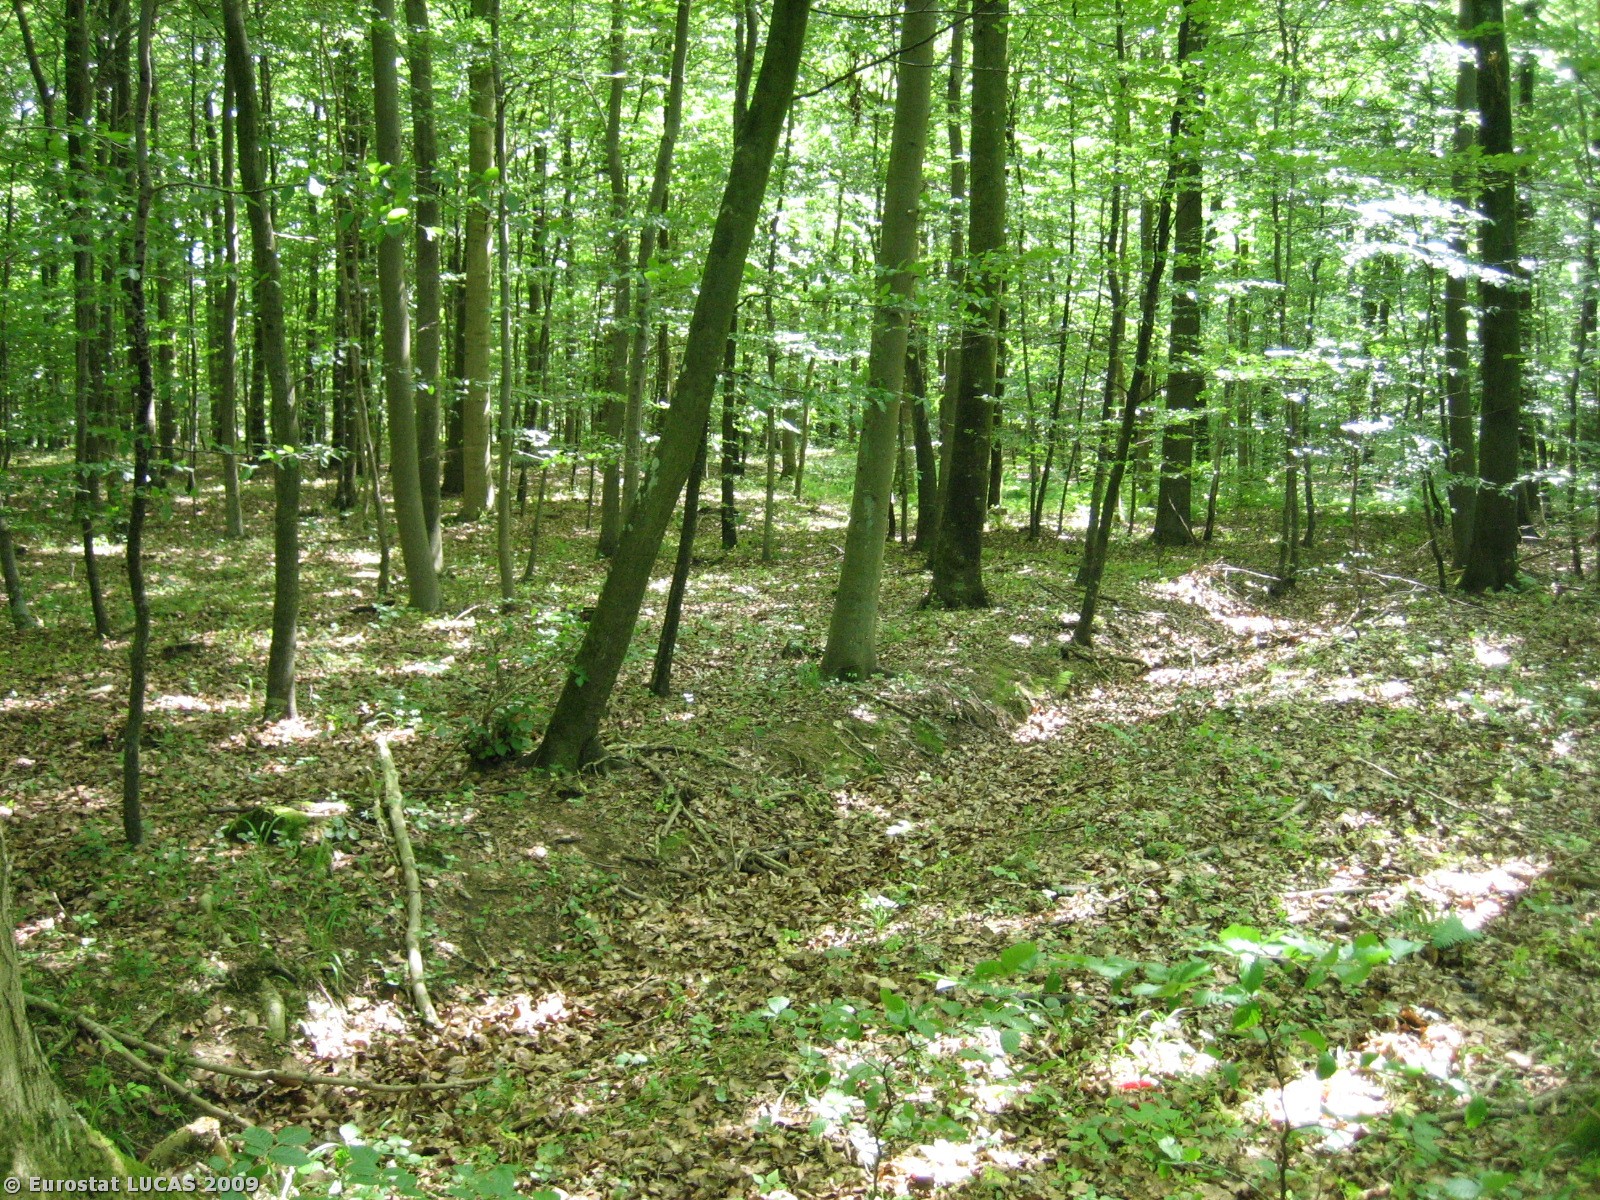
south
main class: Woodland
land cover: Broadleaved woodland
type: mesophytic deciduous forest
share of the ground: > 75 %
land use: Forestry
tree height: > 5 m
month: June
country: DK
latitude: 55.6844
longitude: 9.8570
